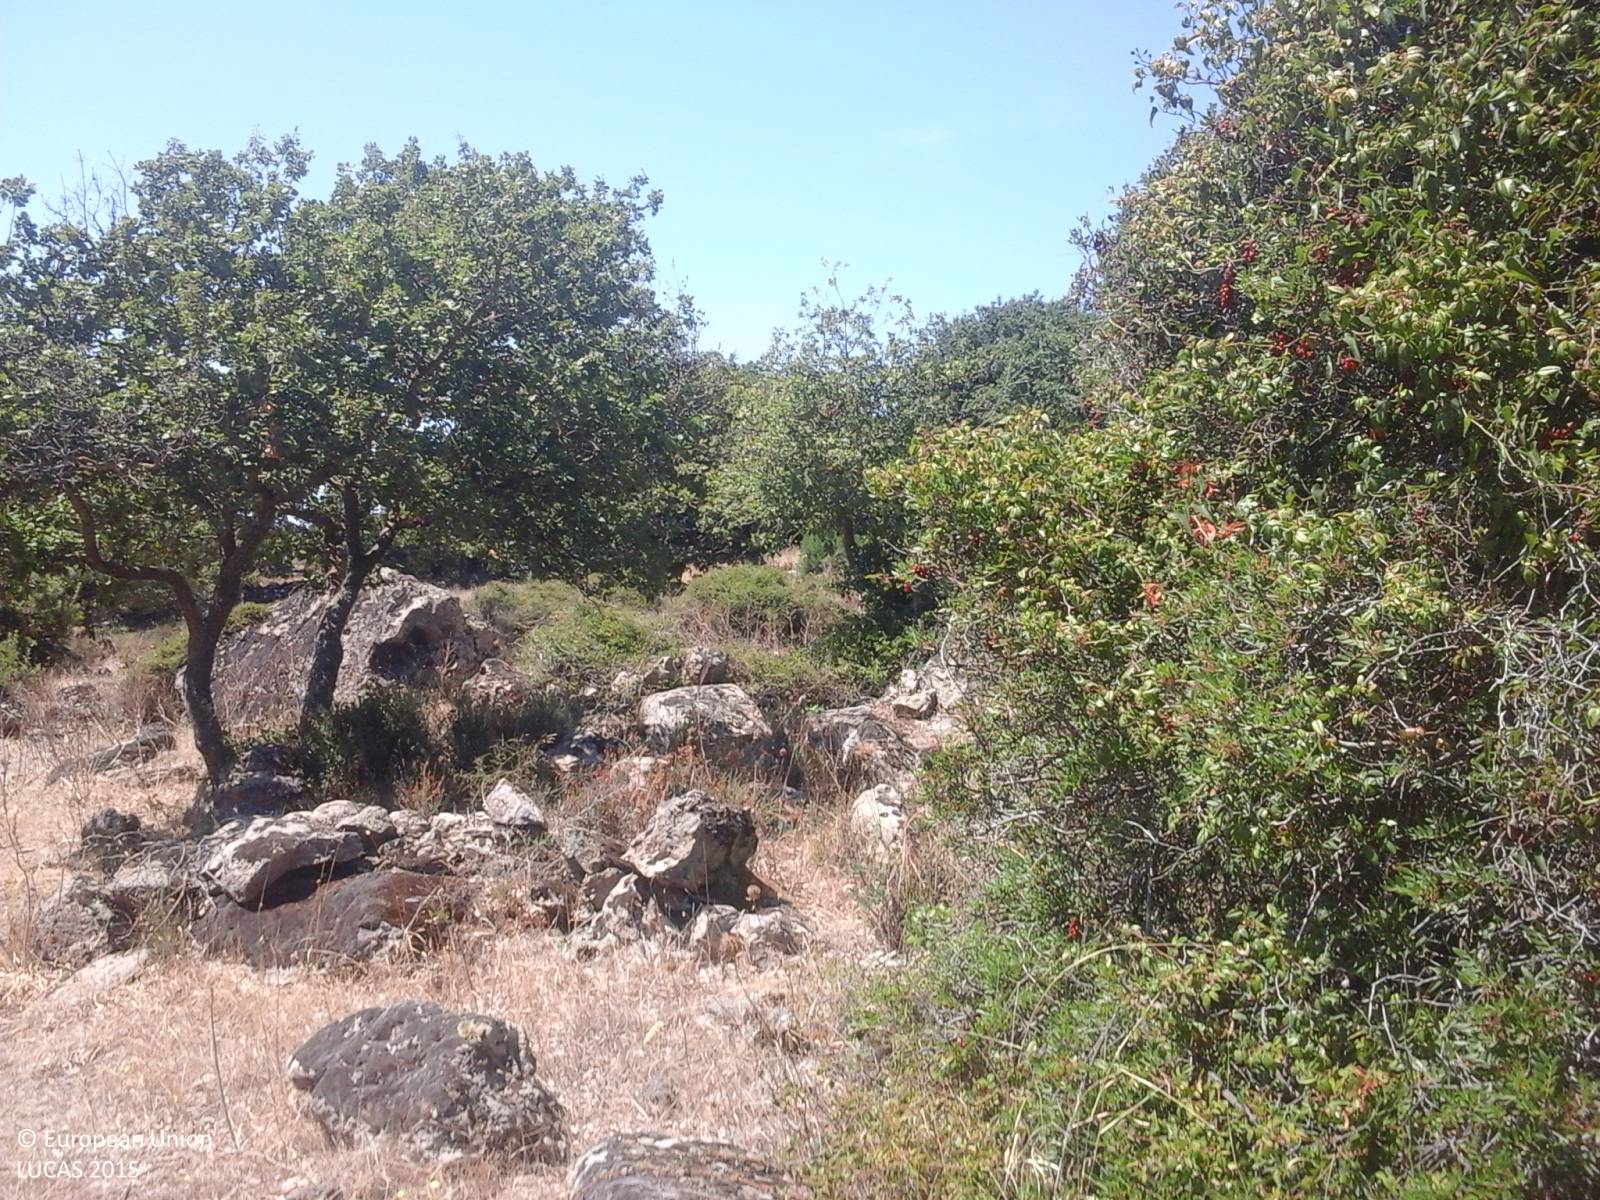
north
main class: Woodland
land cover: Broadleaved woodland
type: broadleaved evergreen forest
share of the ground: > 75 %
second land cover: Grassland without tree/shrub cover
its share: 50 - 75 %
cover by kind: broadleaved forest trees 60 %, shrubs 15 %, herbaceous plants 10 %, unconsolidated bare surface 10 %, consolidated bare surface 5 %
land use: Forestry
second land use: Agriculture (excluding fallow land and kitchen gardens)
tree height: > 5 m
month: August
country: IT
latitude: 39.7031
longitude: 9.2463
